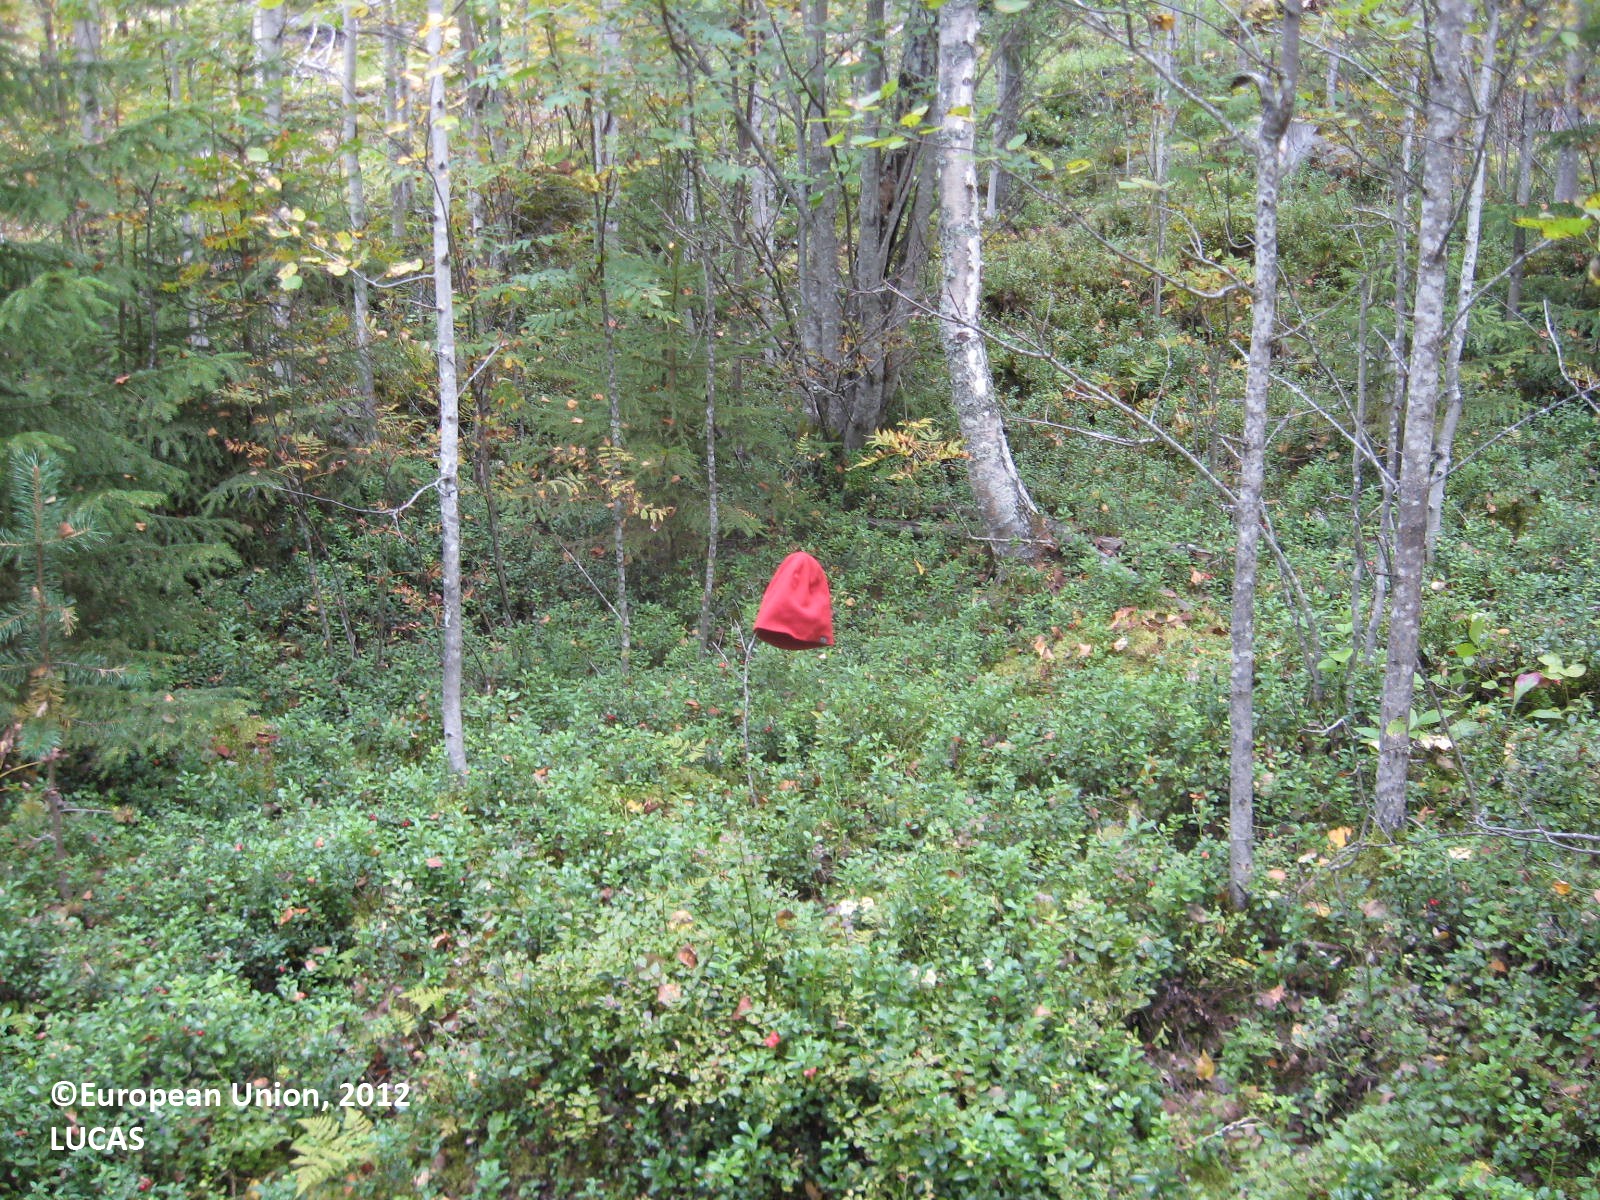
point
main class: Woodland
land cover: Broadleaved woodland
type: boreal forest
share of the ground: > 75 %
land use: Forestry
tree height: > 5 m
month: September
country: FI
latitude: 64.0209
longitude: 28.1983
